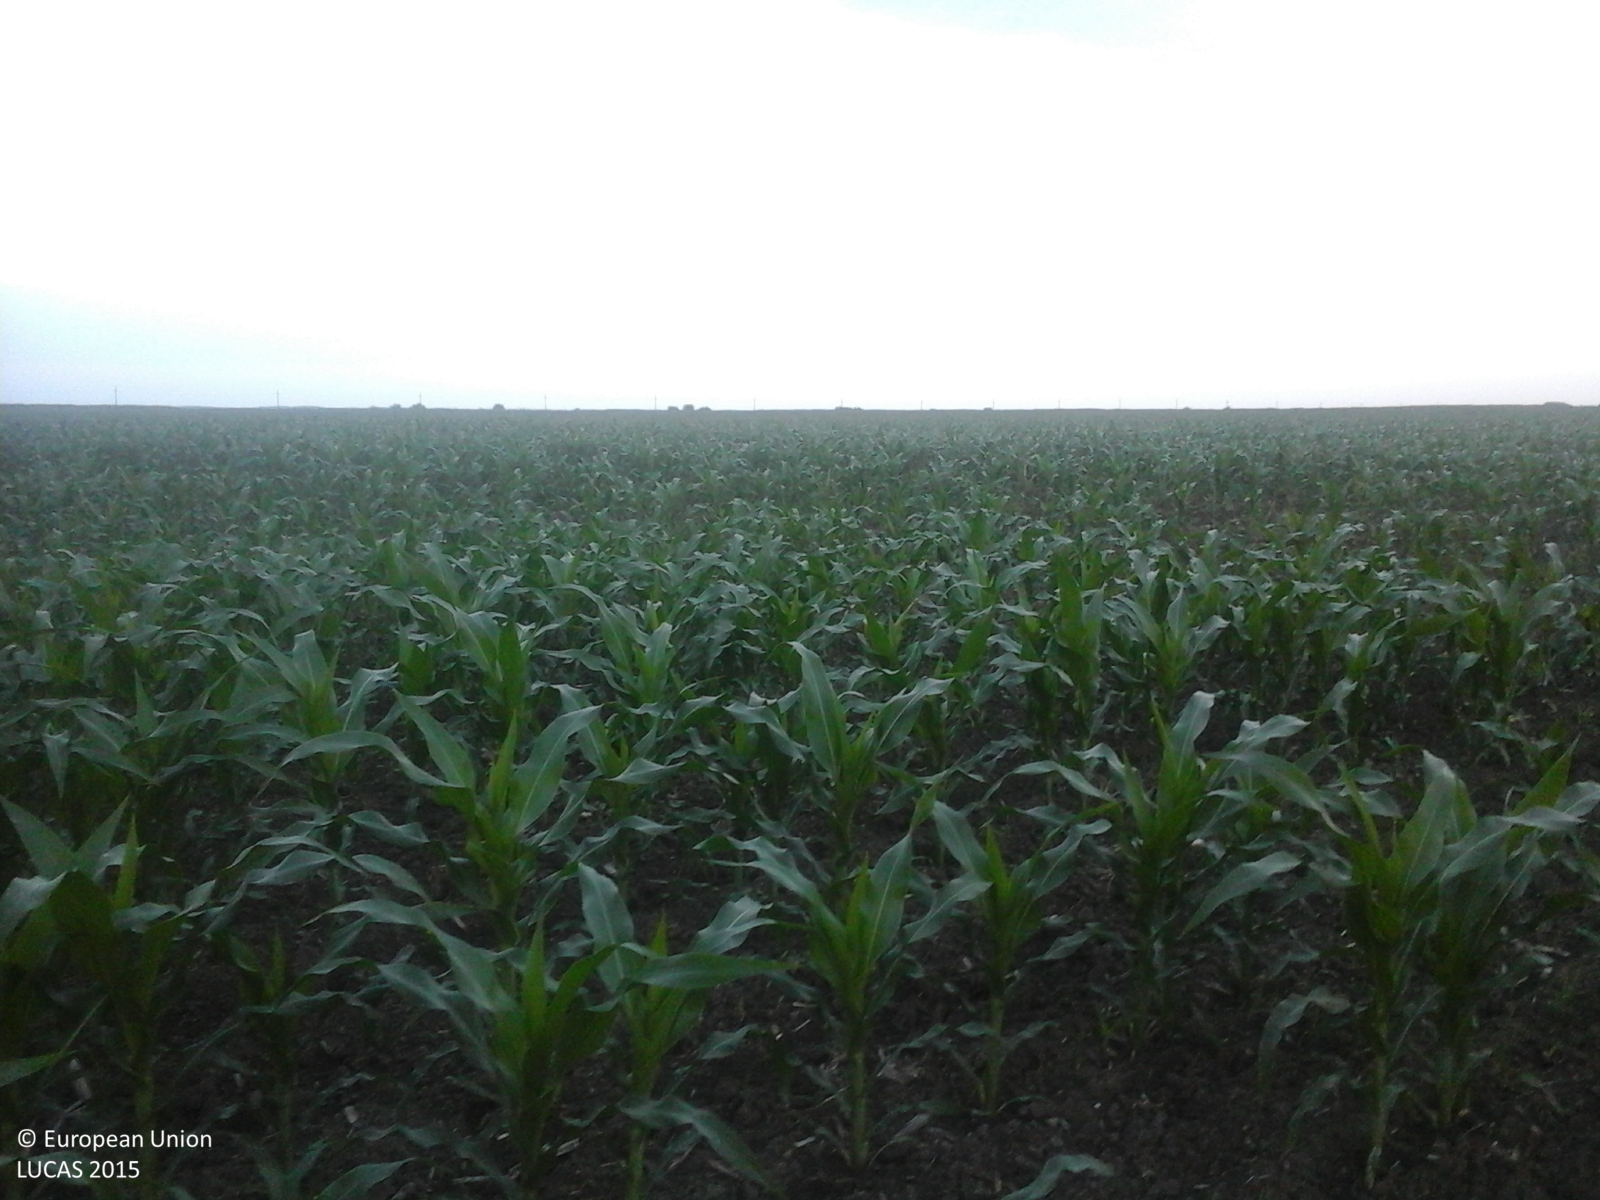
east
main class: Cropland
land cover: Maize
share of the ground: 25 - 50 %
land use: Agriculture (excluding fallow land and kitchen gardens)
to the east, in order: Maize
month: June
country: RO
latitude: 44.0365
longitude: 26.1111
